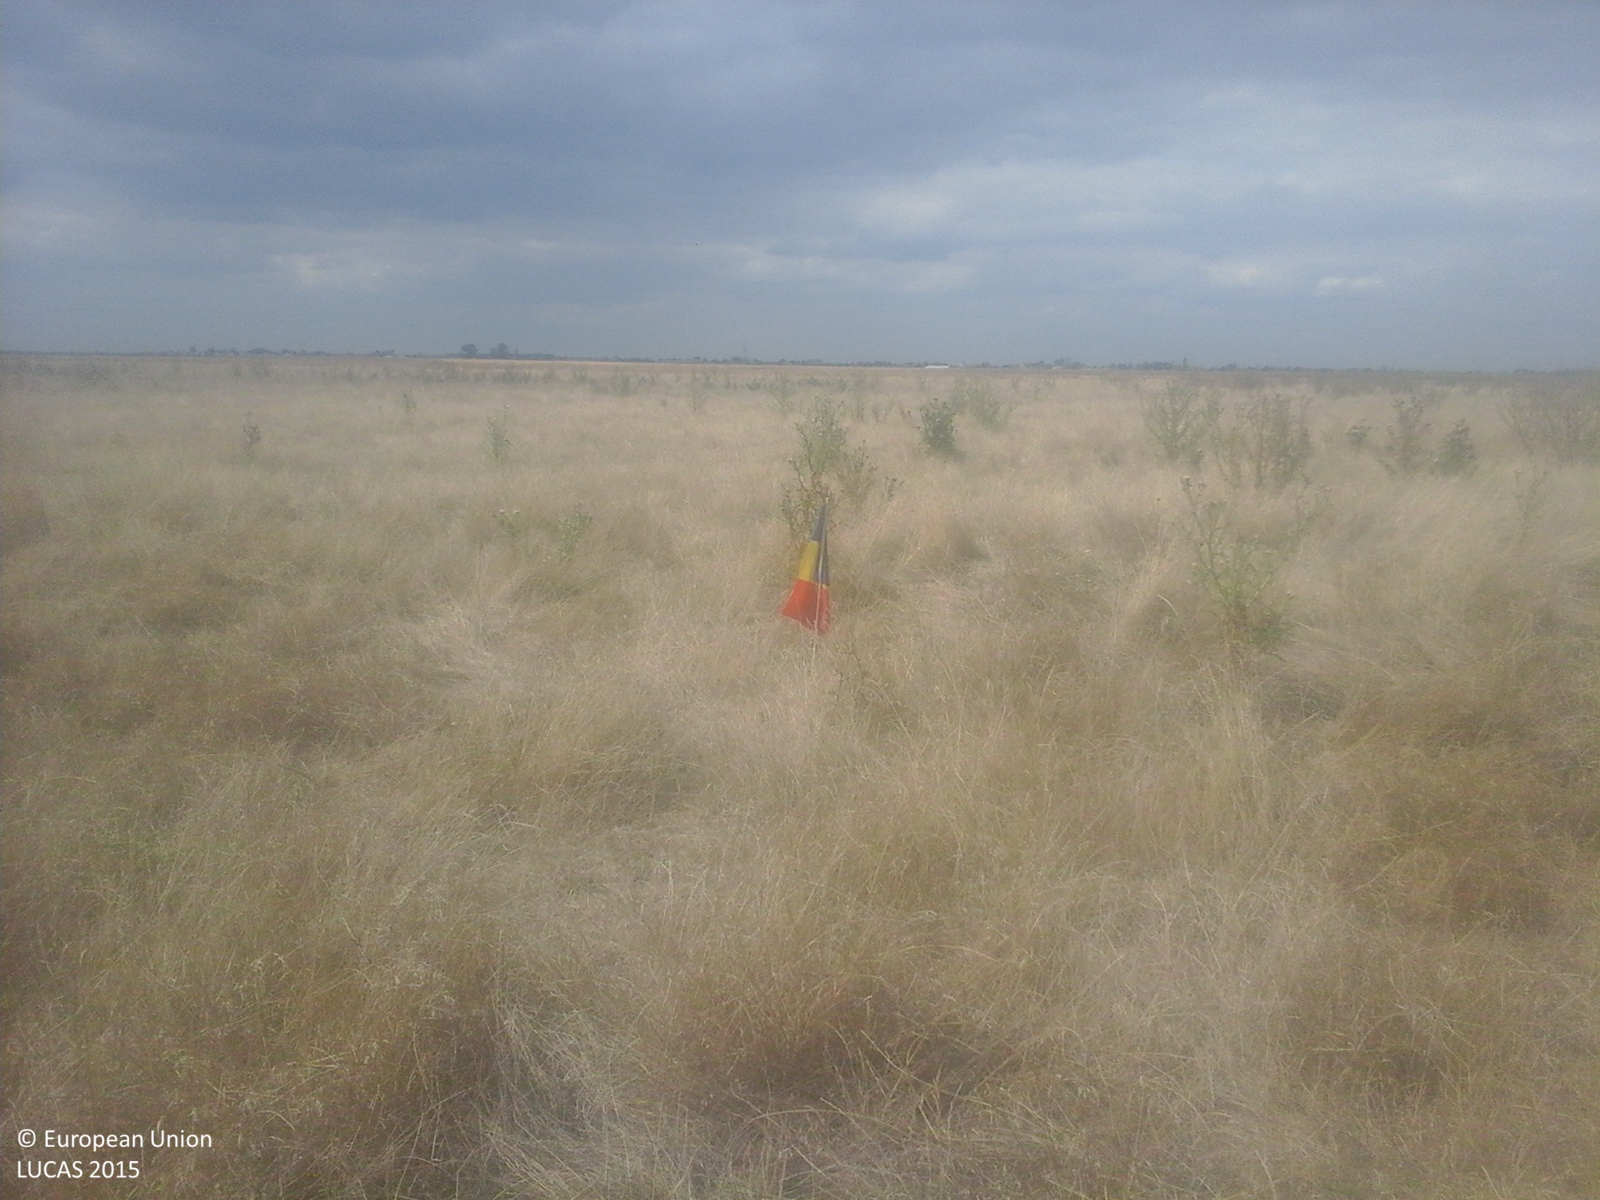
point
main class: Grassland
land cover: Spontaneously vegetated surfaces
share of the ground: > 75 %
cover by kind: herbaceous plants 100 %
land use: Fallow land
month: September
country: RO
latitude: 47.7261
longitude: 22.8224
